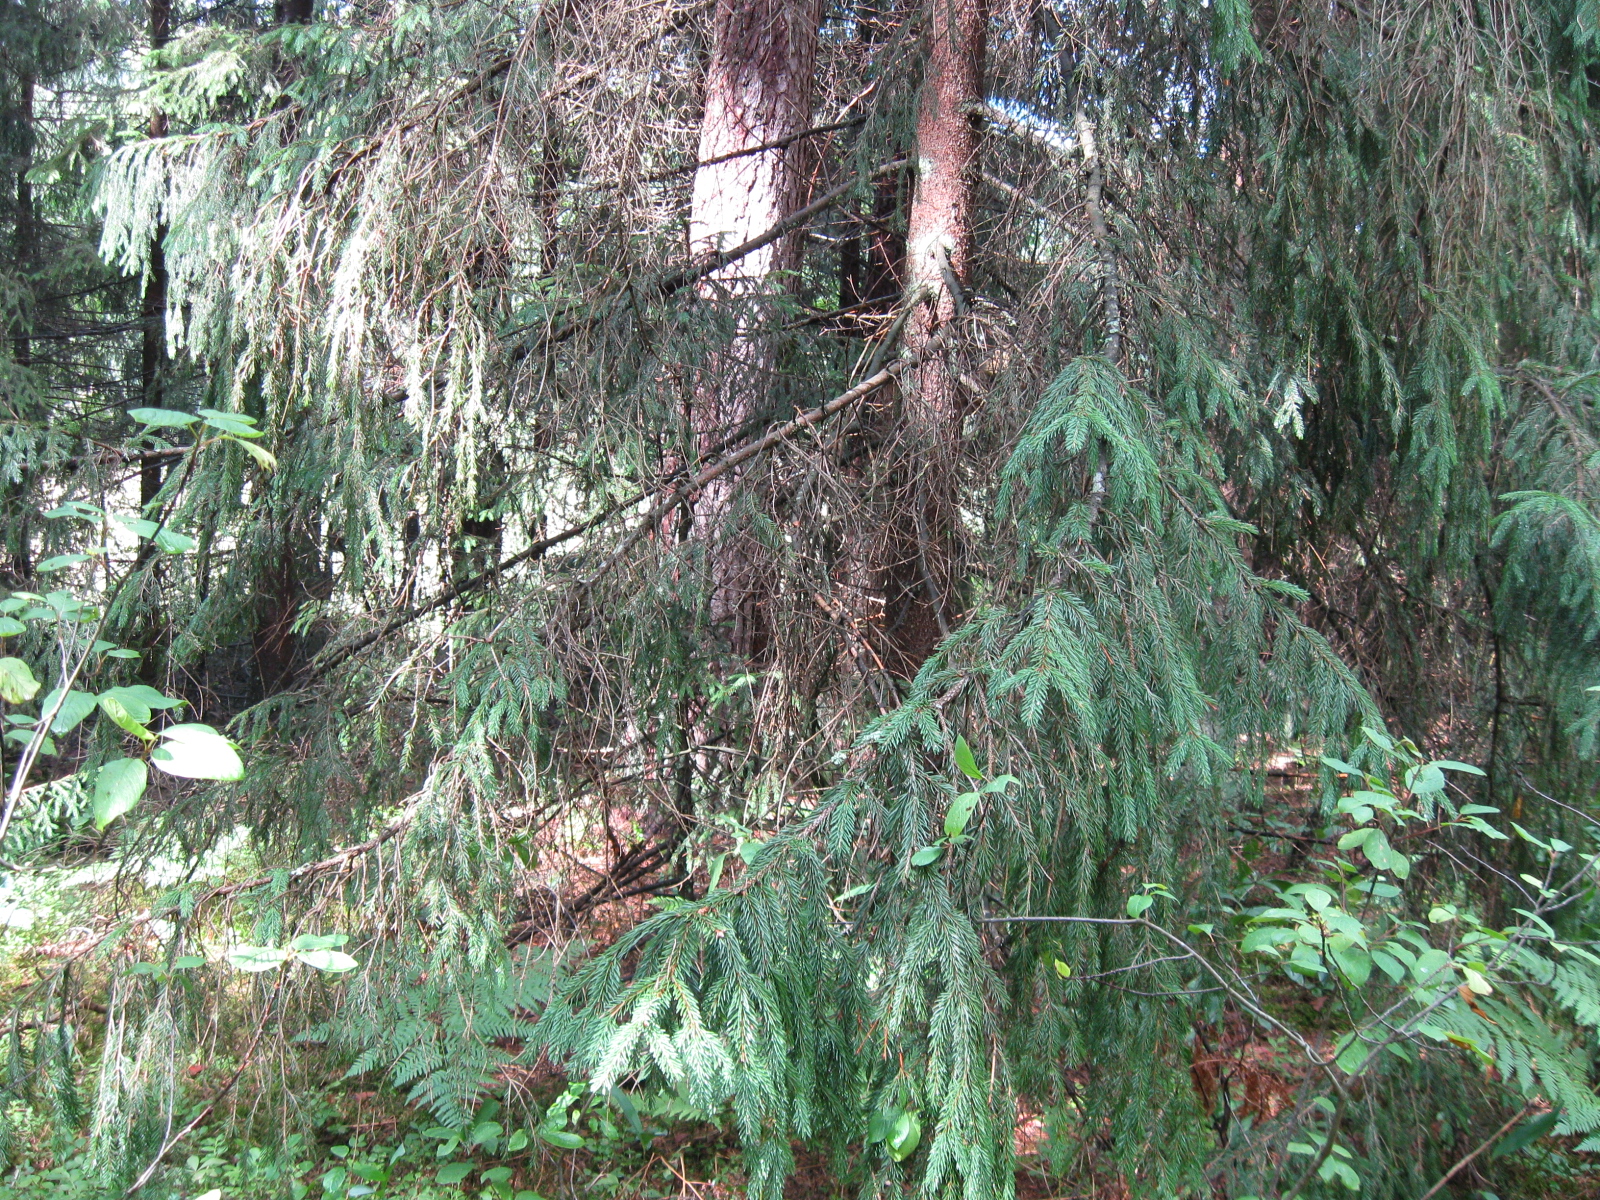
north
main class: Woodland
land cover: Other coniferous woodland
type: hemiboreal forest and nemoral coniferous forest and mixed broadleaved-coniferous forest
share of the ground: > 75 %
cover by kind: coniferous forest trees 80 %, lichens and mosses 10 %, broadleaved forest trees 5 %, herbaceous plants 5 %
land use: Forestry
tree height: > 5 m
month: July
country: LT
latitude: 53.9582
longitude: 23.6343
